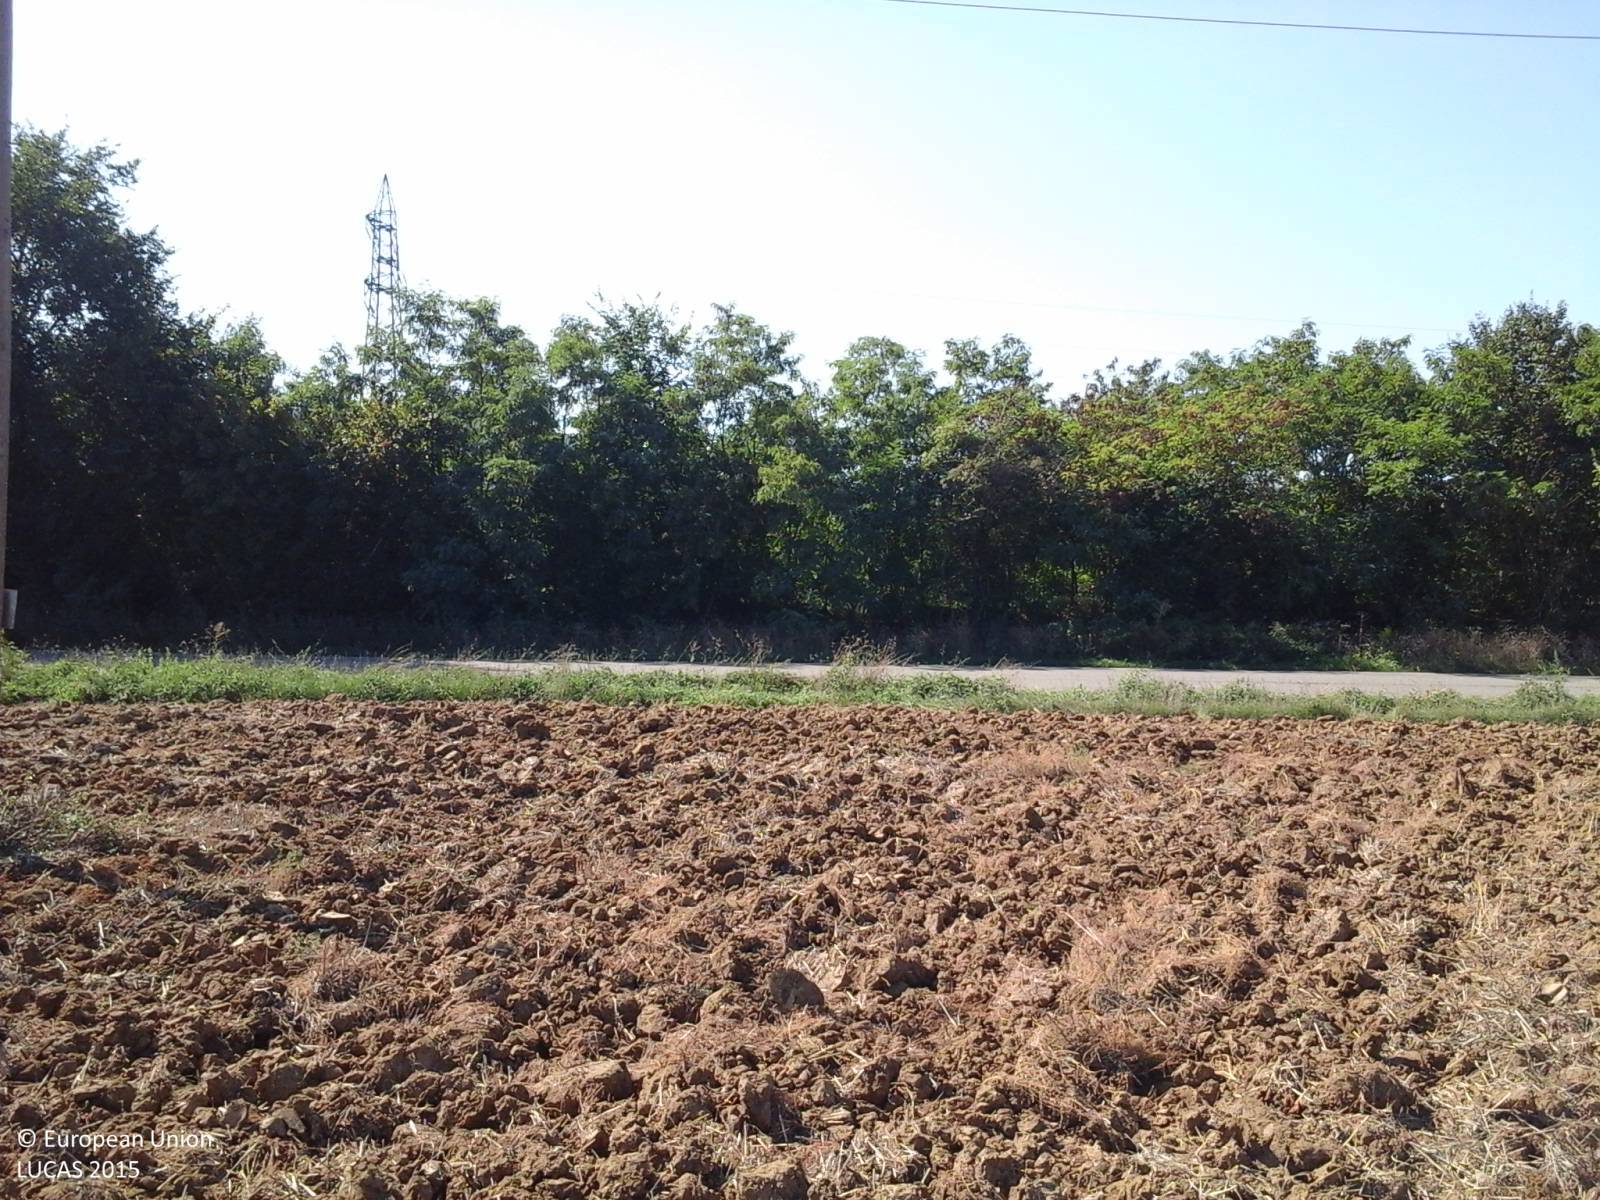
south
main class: Cropland
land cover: Common wheat
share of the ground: < 10 %
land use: Agriculture (excluding fallow land and kitchen gardens)
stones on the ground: 10 - 25 %
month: September
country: IT
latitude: 43.0092
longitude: 12.2140
